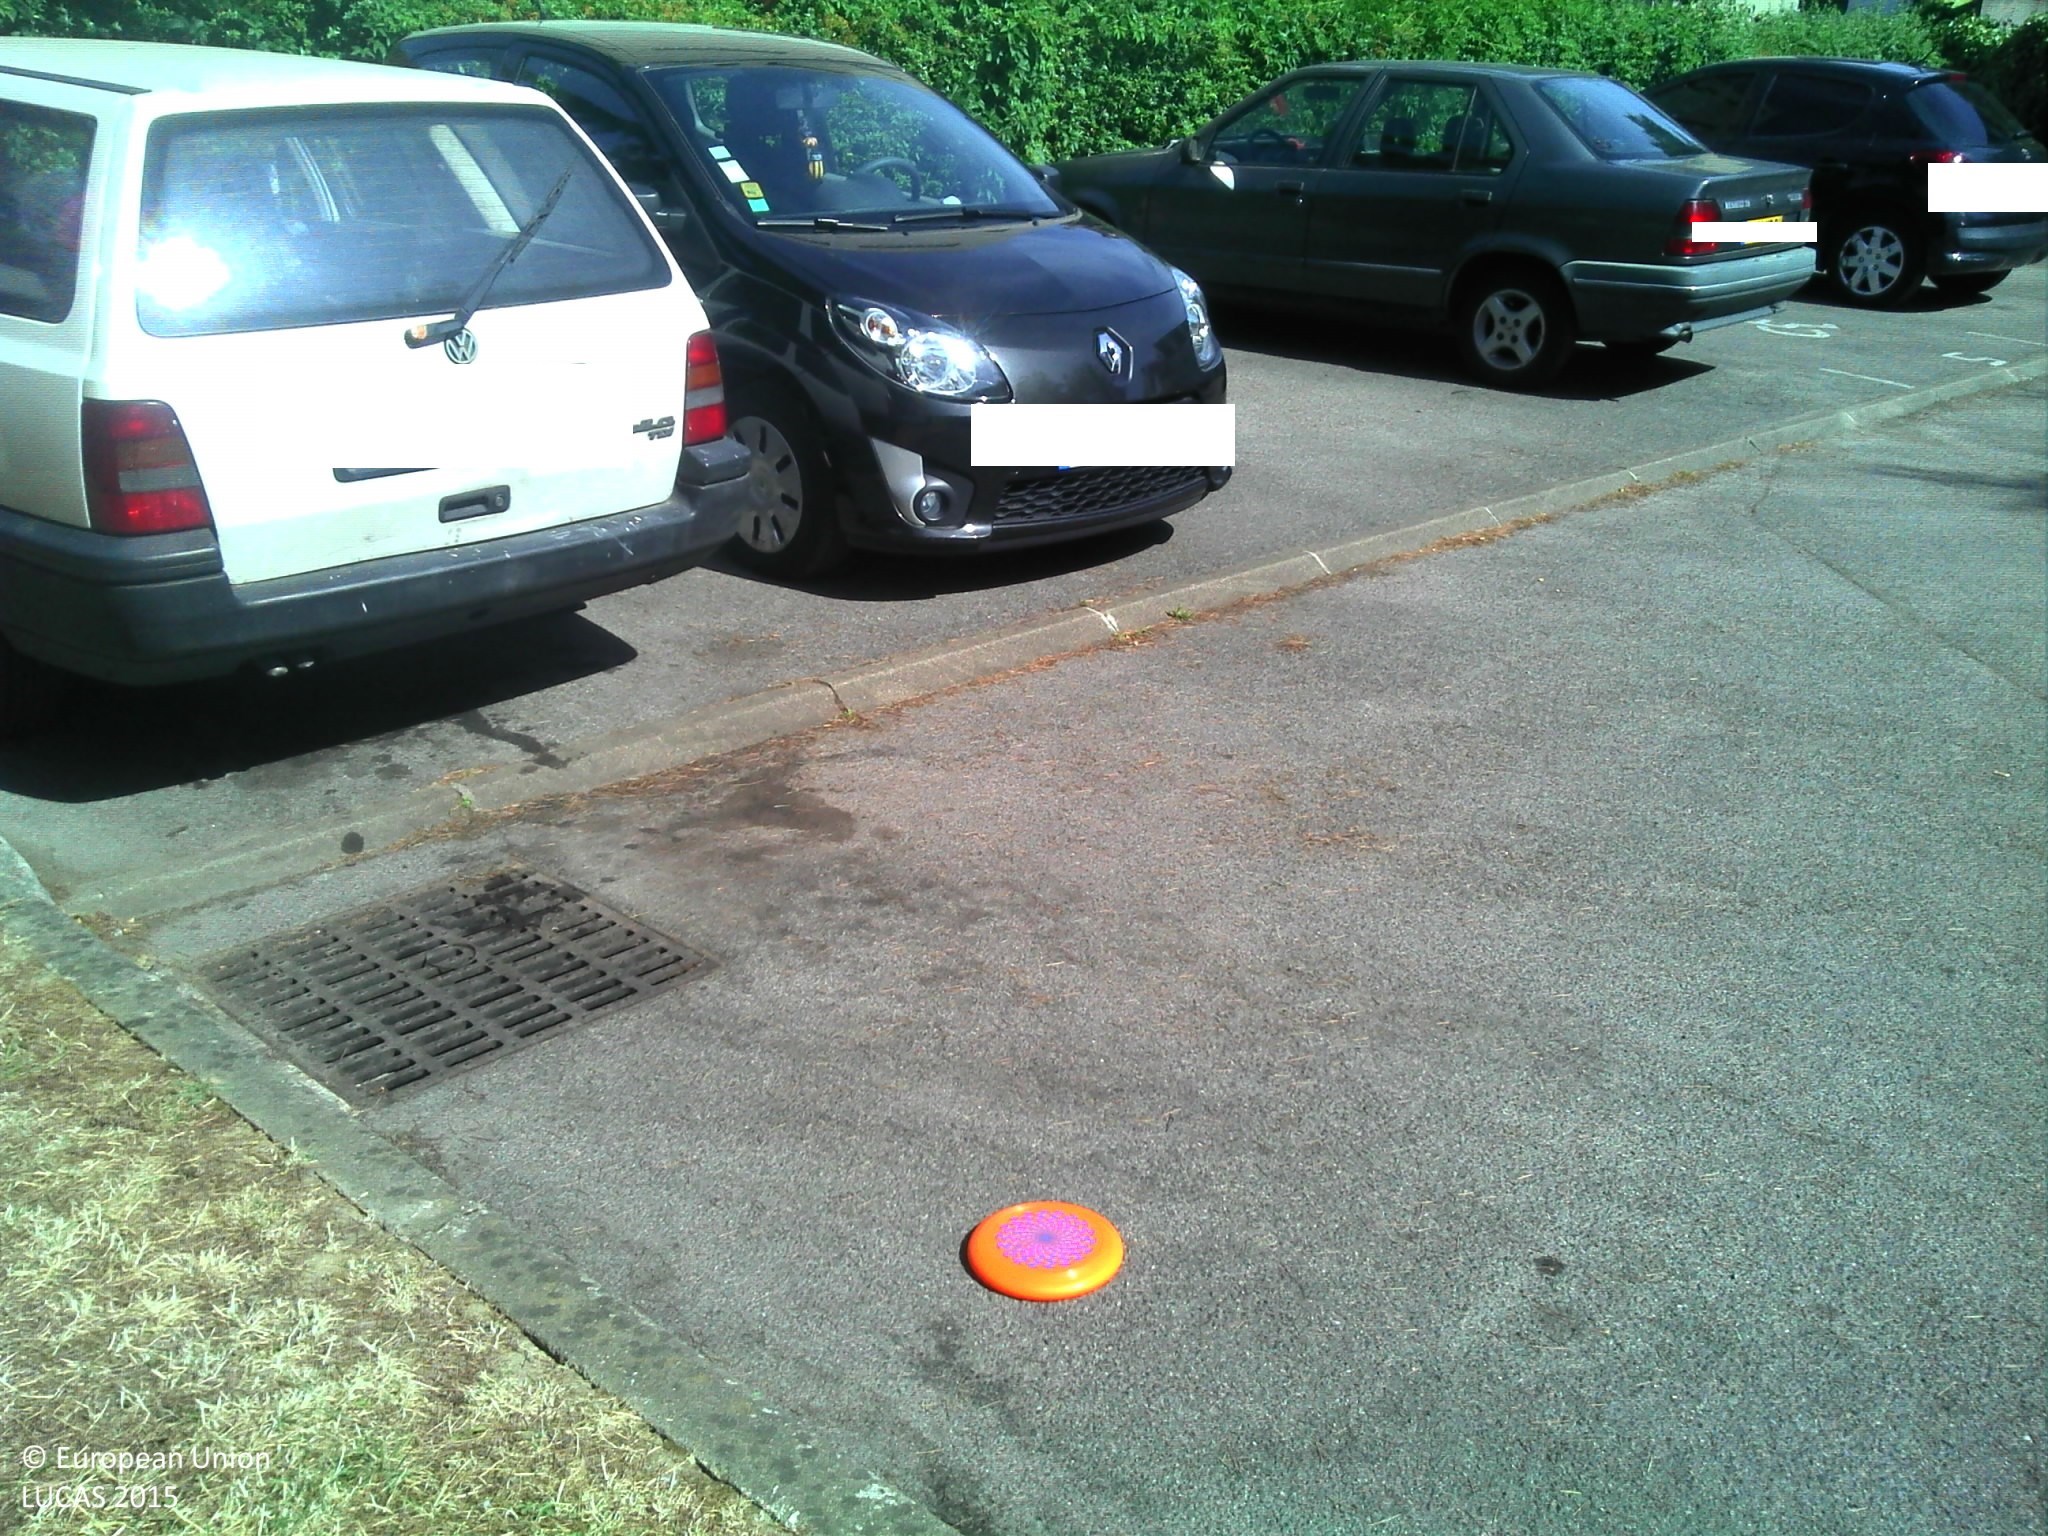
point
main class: Grassland
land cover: Grassland with sparse tree/shrub cover
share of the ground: > 75 %
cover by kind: herbaceous plants 95 %, broadleaved forest trees 5 %
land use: Road transport
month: August
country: FR
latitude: 48.8124
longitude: 2.4306
